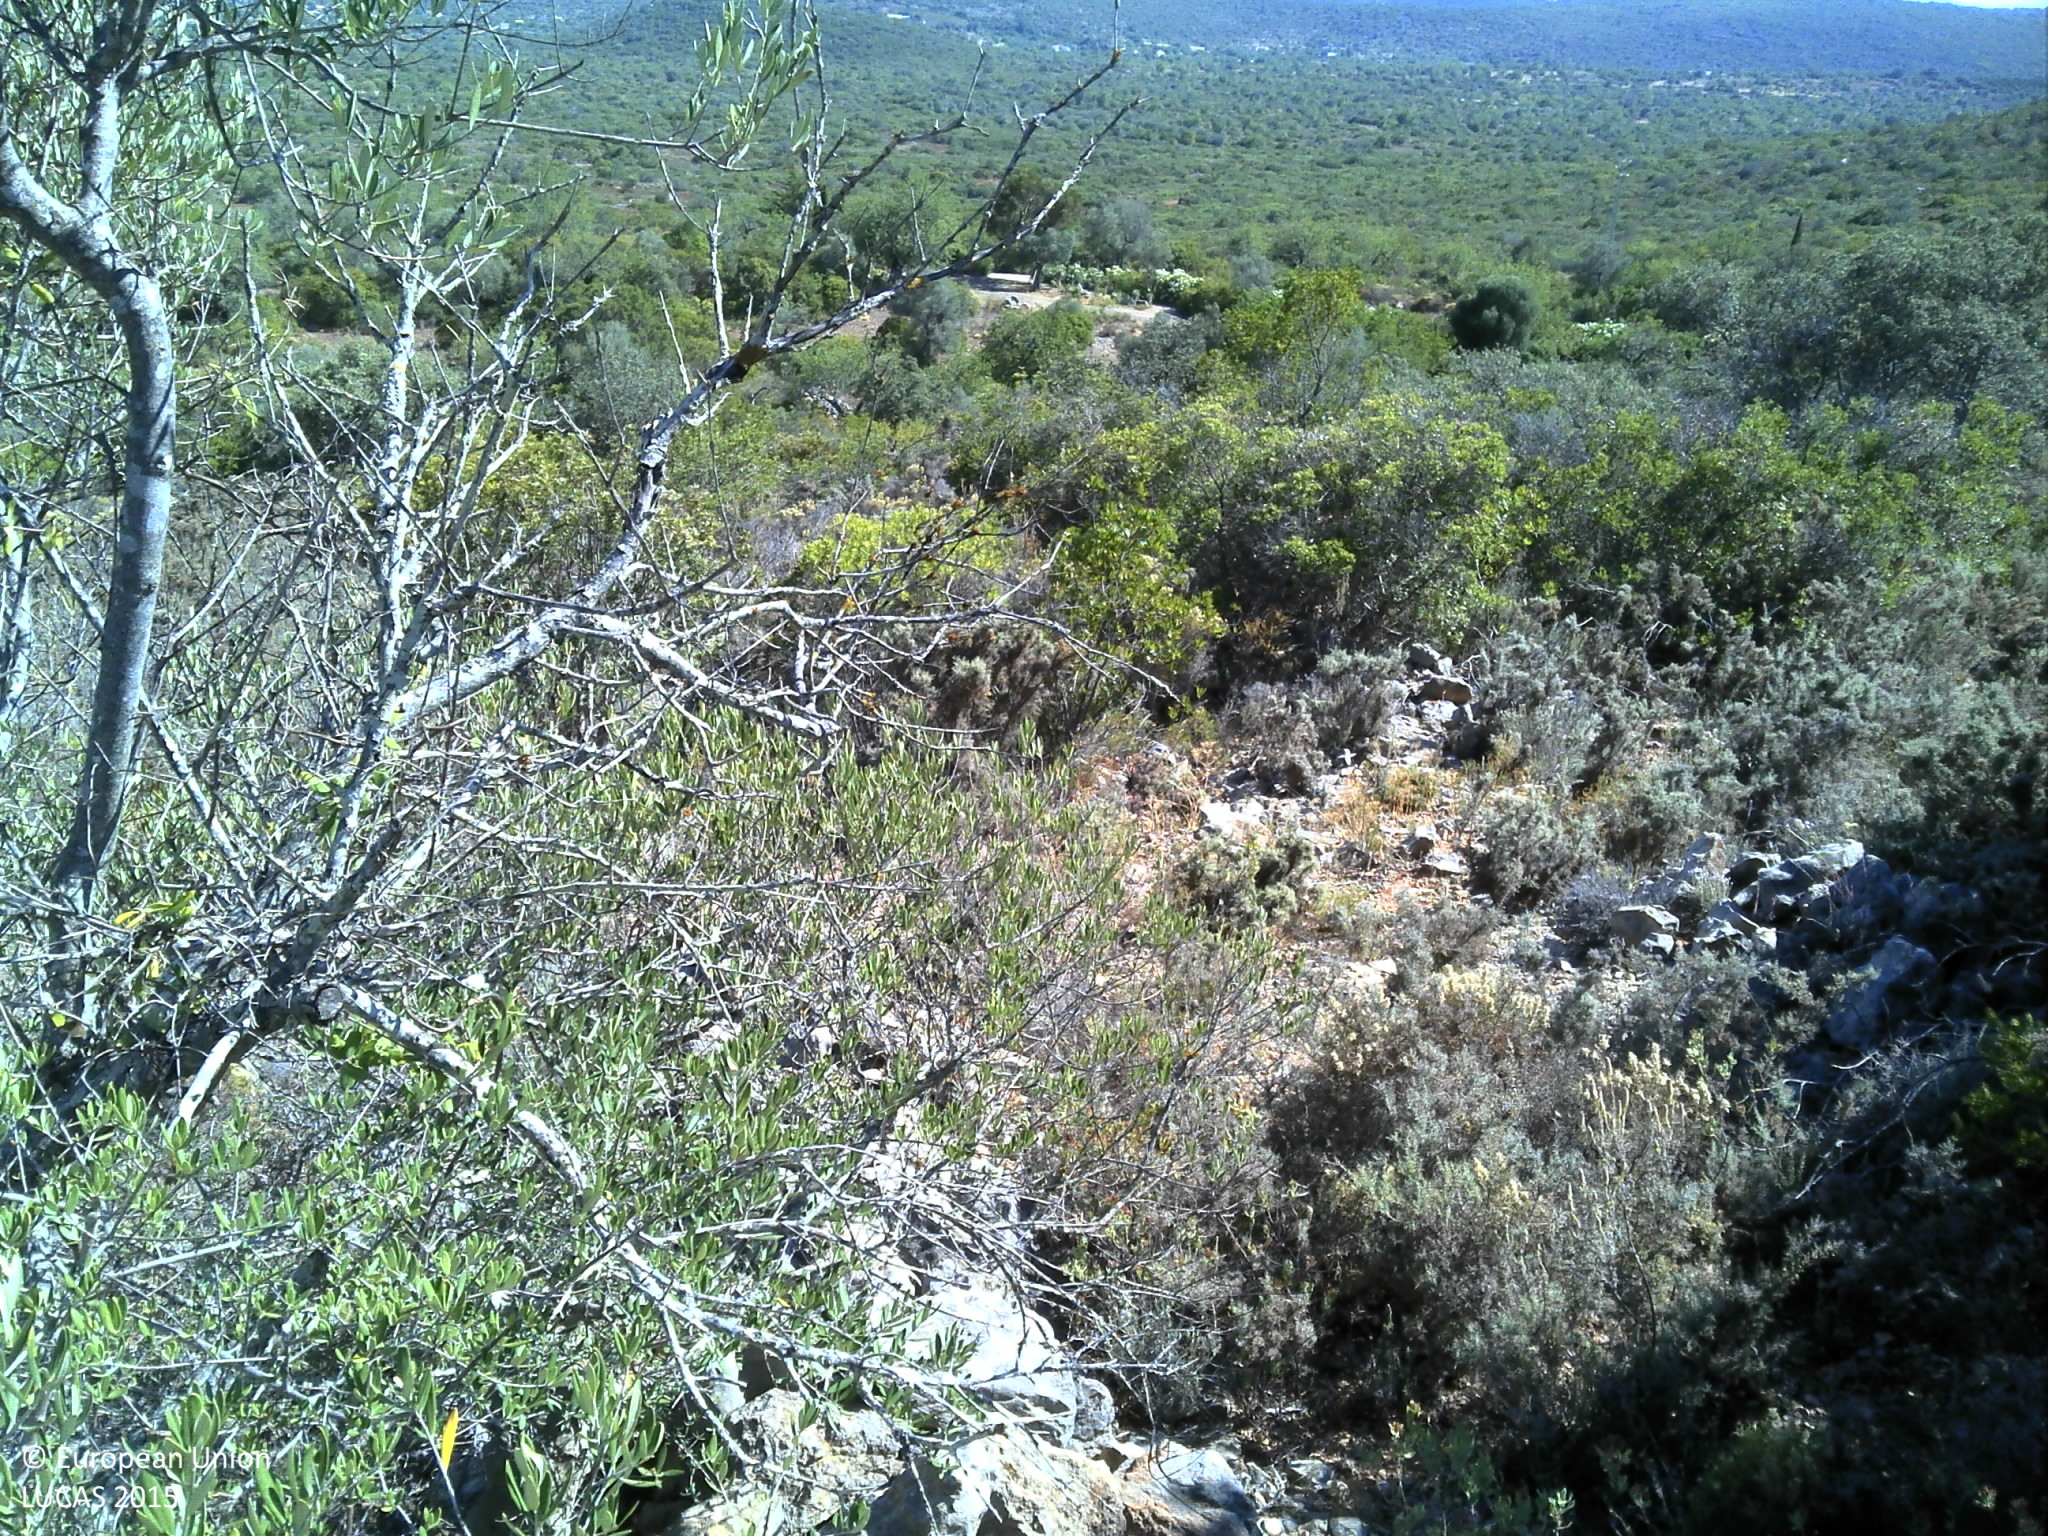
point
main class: Shrubland
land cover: Shrubland with sparse tree cover
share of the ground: > 75 %
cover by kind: shrubs 90 %, broadleaved forest trees 5 %, unconsolidated bare surface 5 %
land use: Abandoned areas
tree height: < 5 m
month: June
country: PT
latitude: 37.1441
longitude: -7.8079
